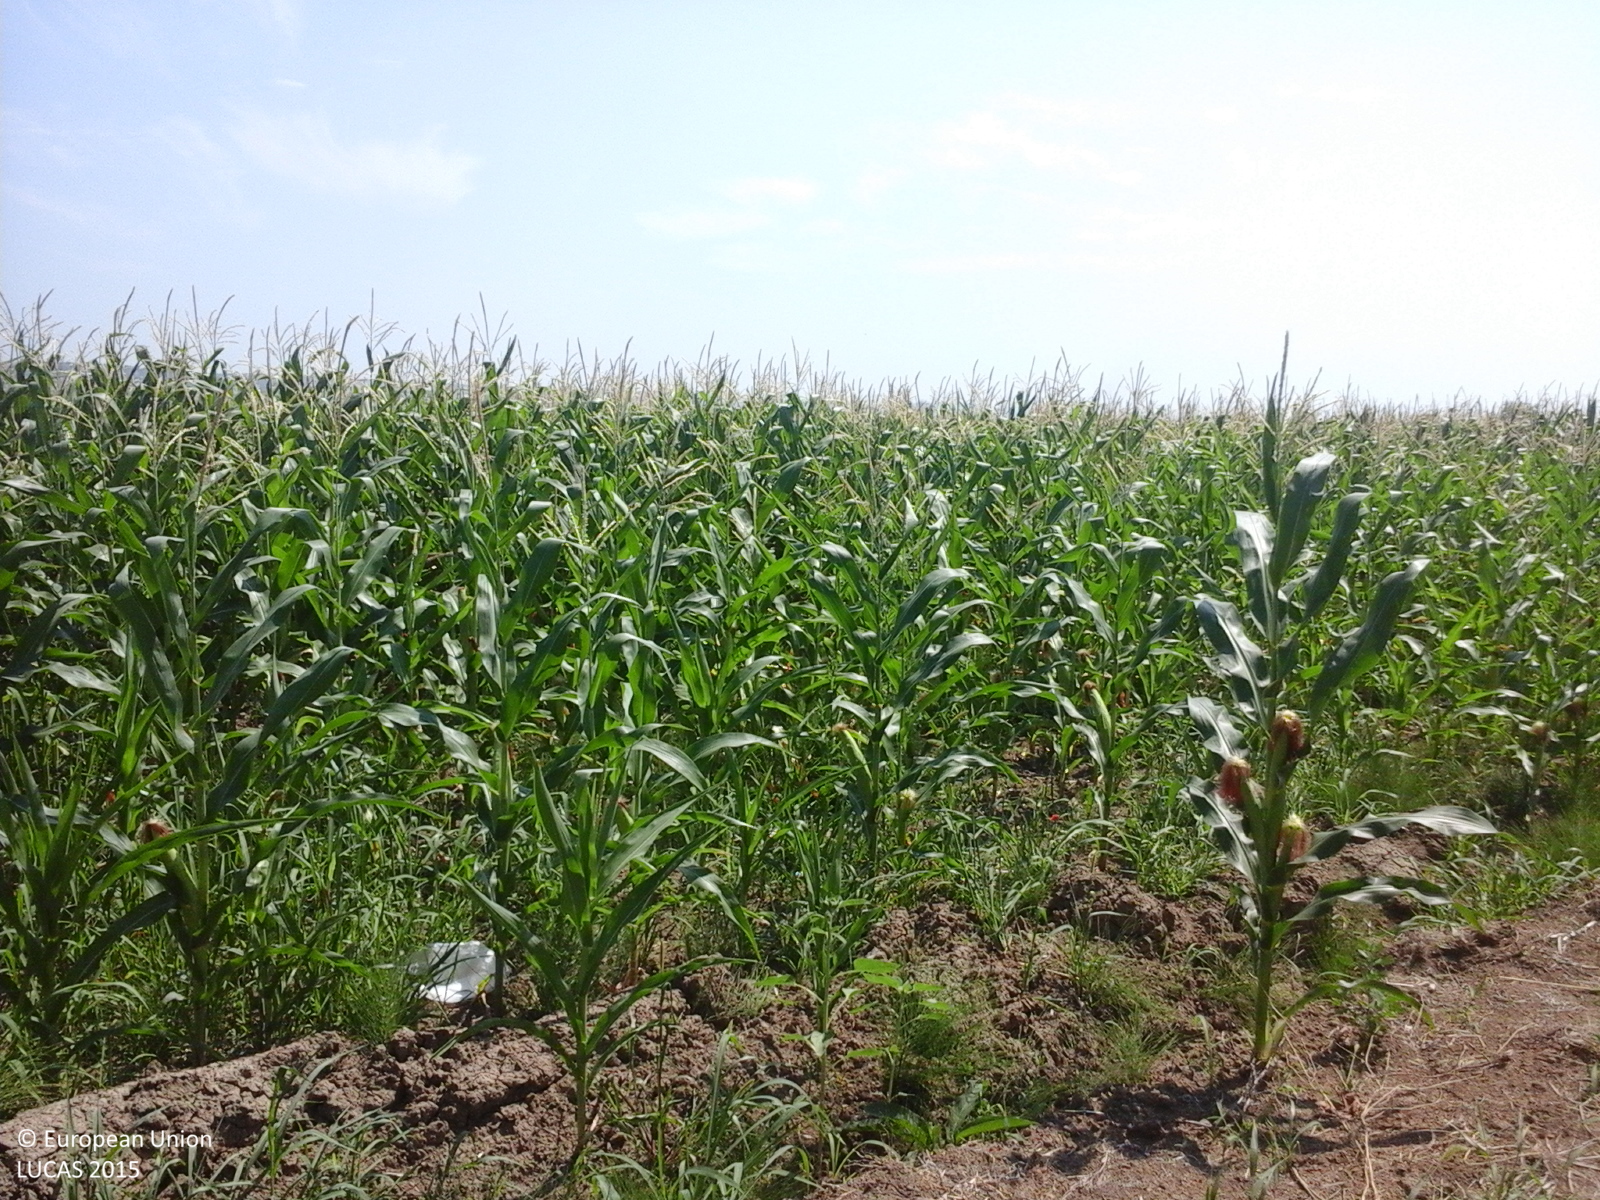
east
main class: Cropland
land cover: Maize
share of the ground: > 75 %
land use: Agriculture (excluding fallow land and kitchen gardens)
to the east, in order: Maize
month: August
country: RO
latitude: 46.2485
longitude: 27.1014
